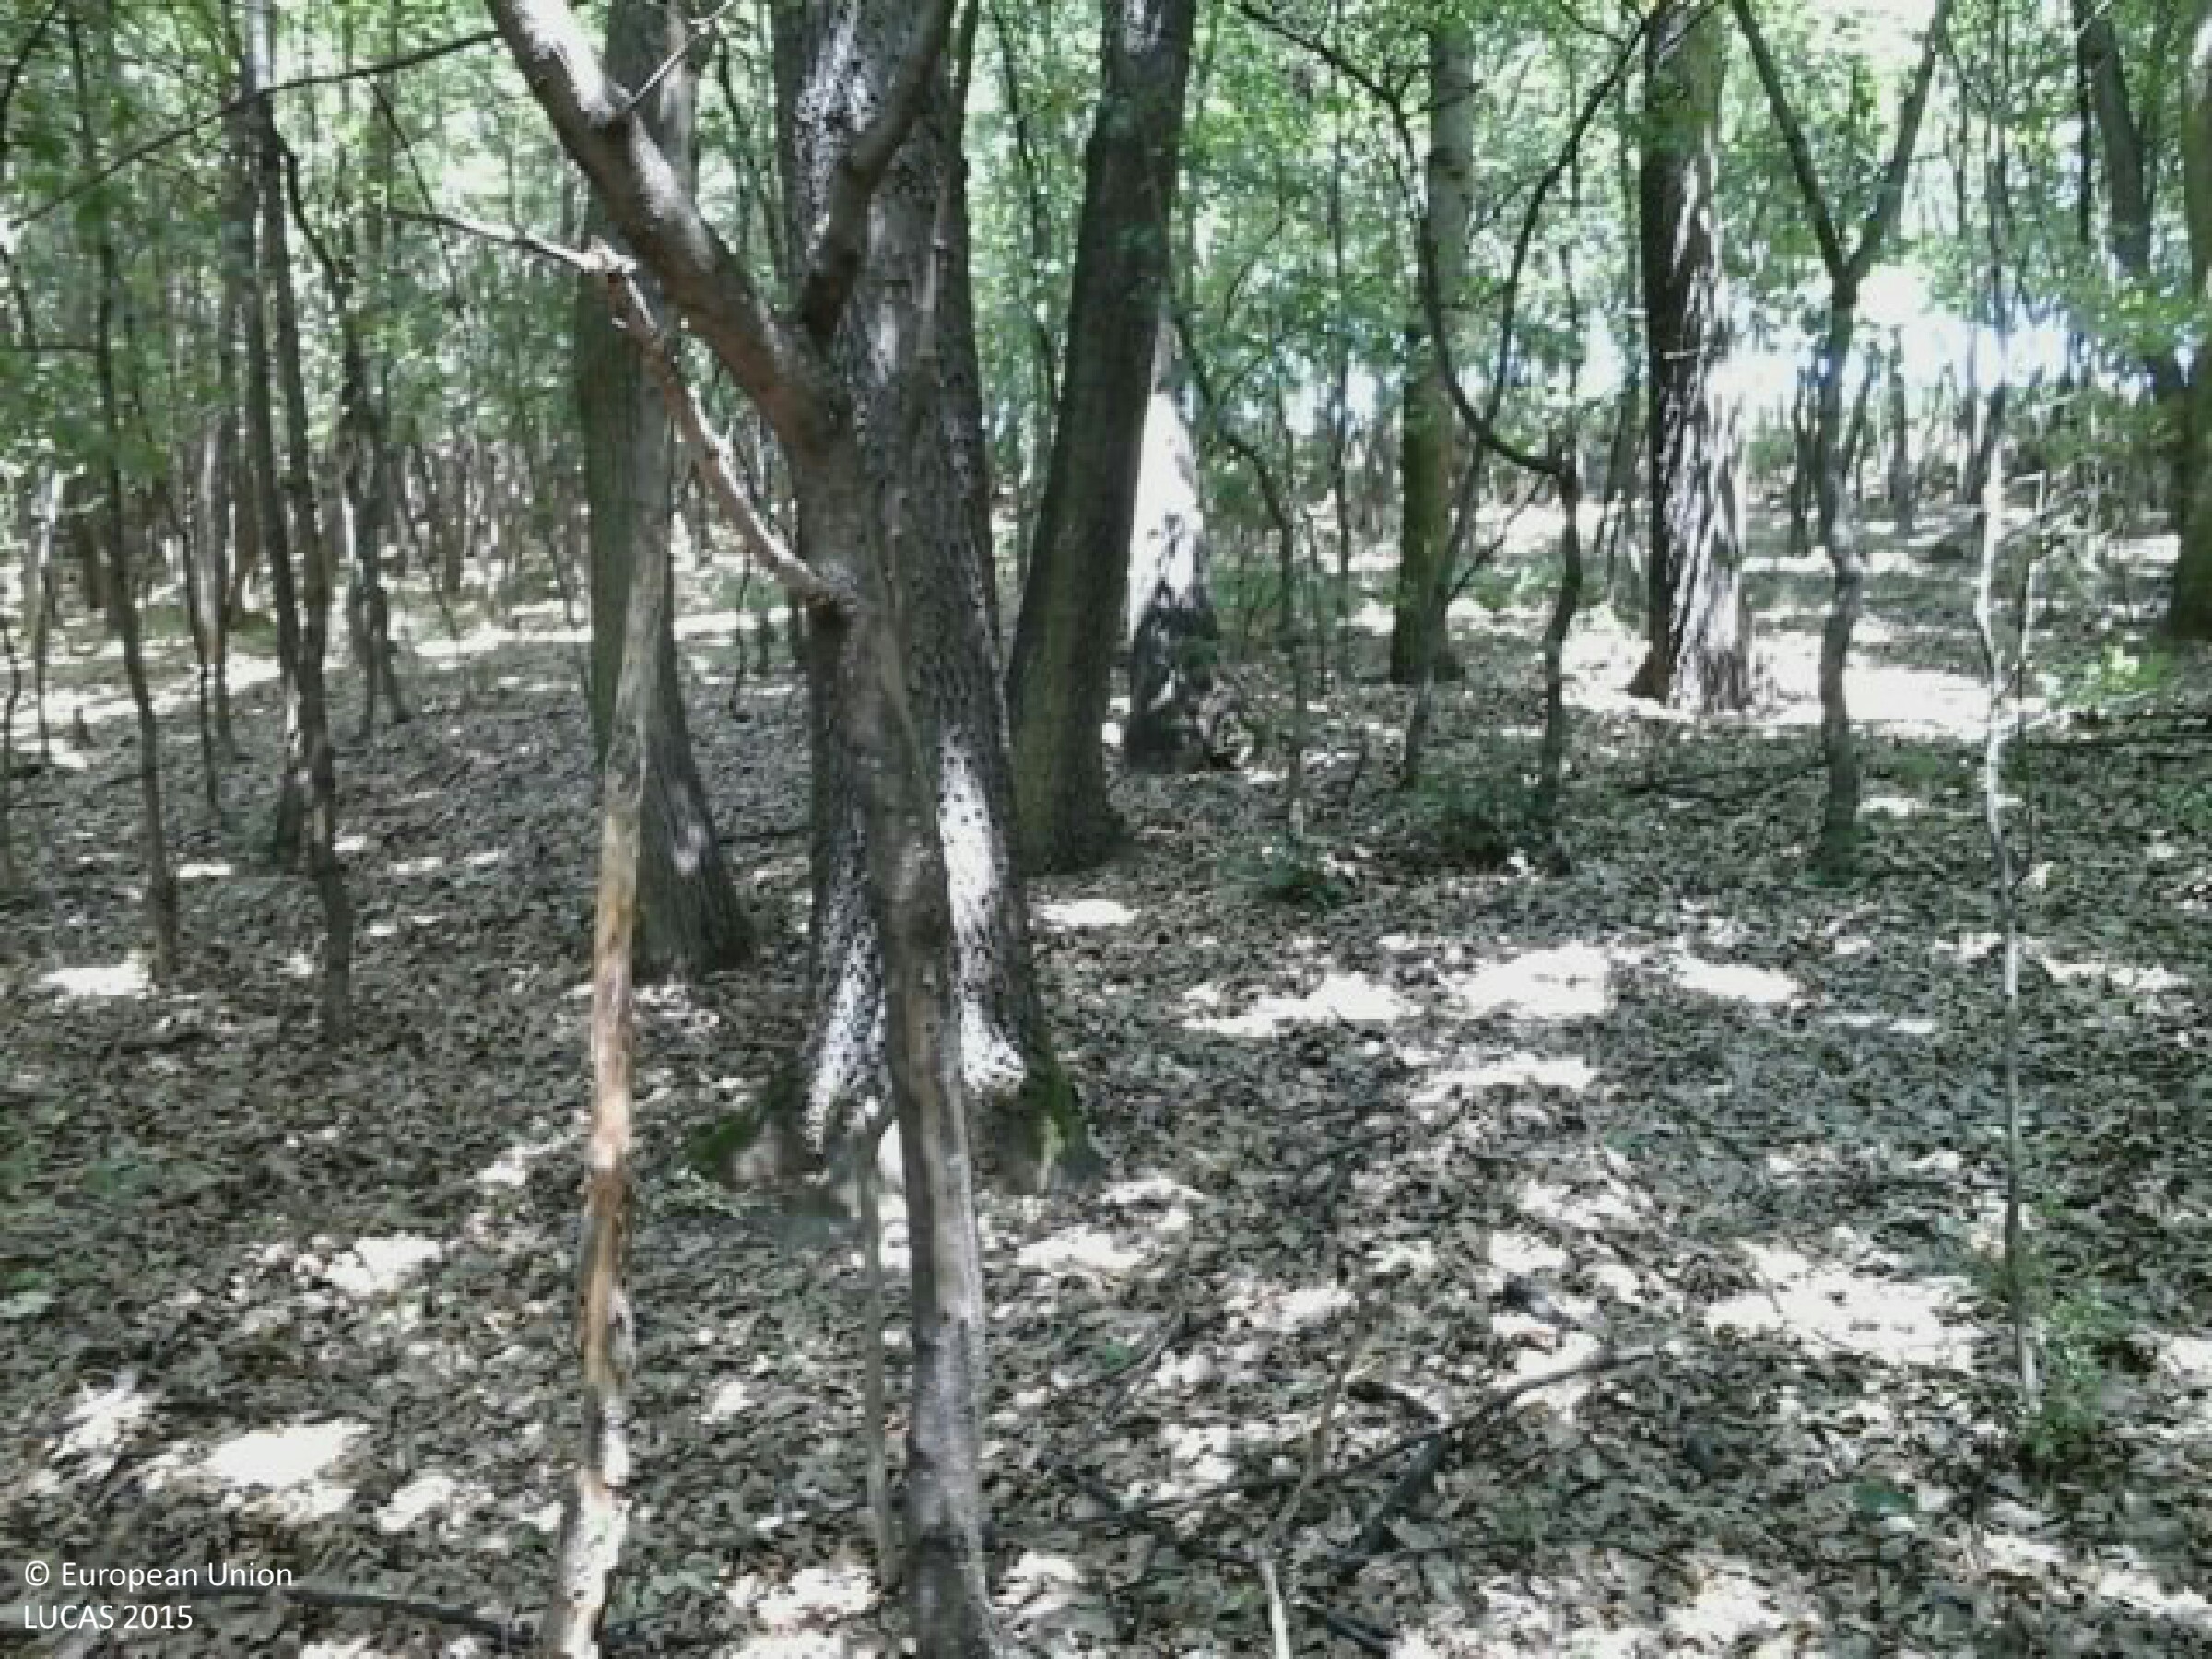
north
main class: Woodland
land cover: Broadleaved woodland
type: mesophytic deciduous forest
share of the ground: > 75 %
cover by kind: broadleaved forest trees 100 %
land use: Forestry
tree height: > 5 m
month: July
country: HU
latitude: 47.8649
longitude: 19.0962
